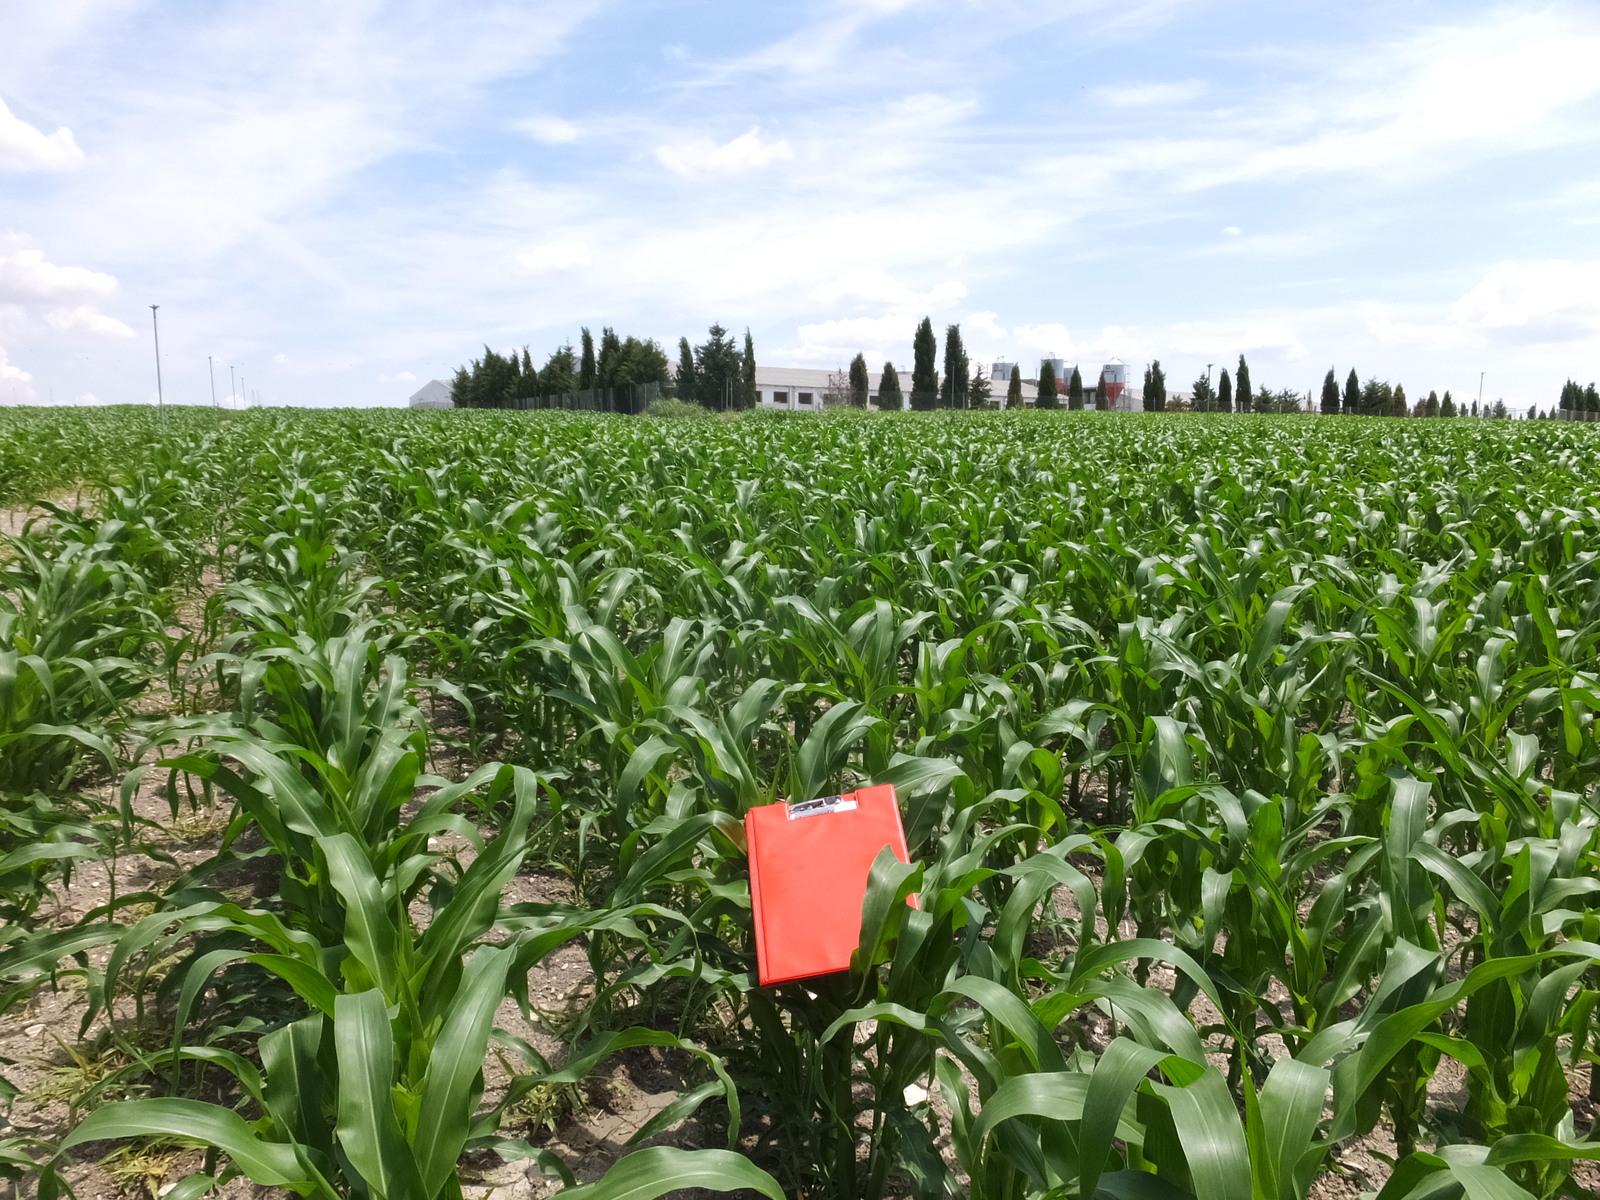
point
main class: Cropland
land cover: Maize
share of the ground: 50 - 75 %
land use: Agriculture (excluding fallow land and kitchen gardens)
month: June
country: ES
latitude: 41.4917
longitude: -0.1126
